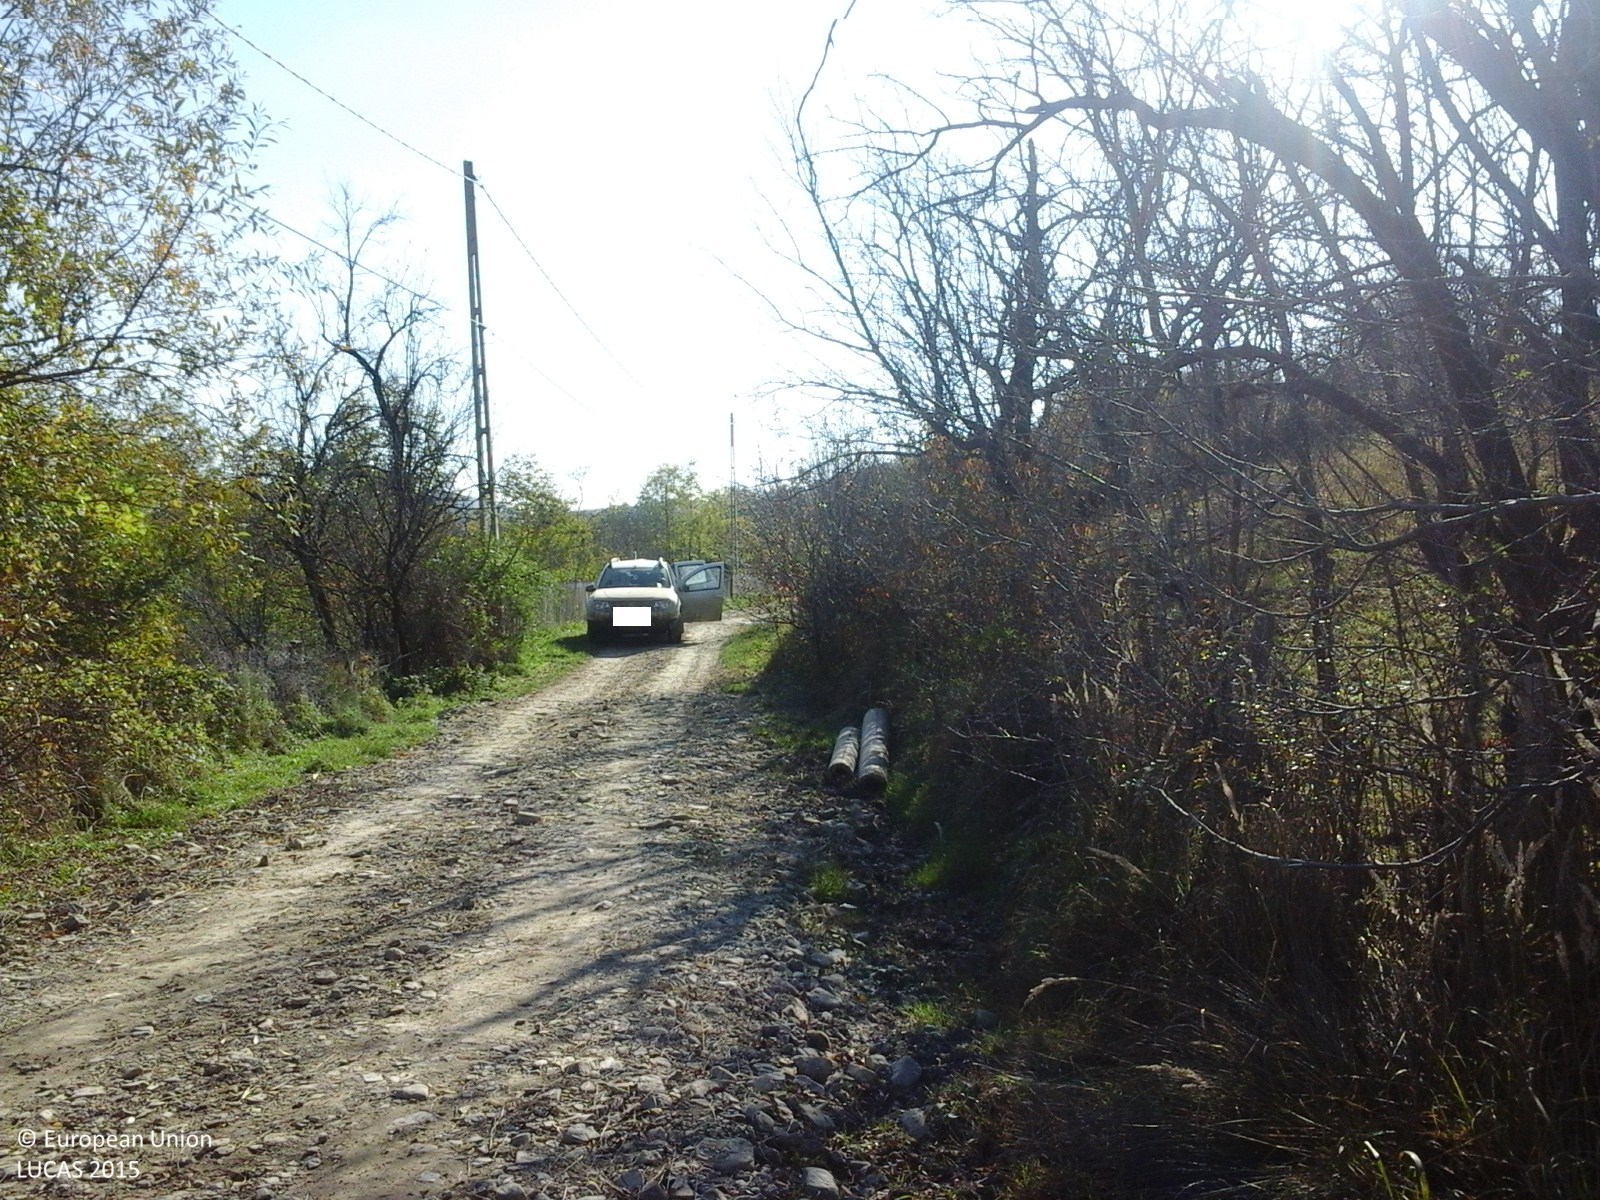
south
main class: Cropland
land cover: Other fruit trees and berries
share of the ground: 50 - 75 %
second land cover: Grassland without tree/shrub cover
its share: > 75 %
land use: Agriculture (excluding fallow land and kitchen gardens)
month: October
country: RO
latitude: 45.4088
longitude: 26.4918
